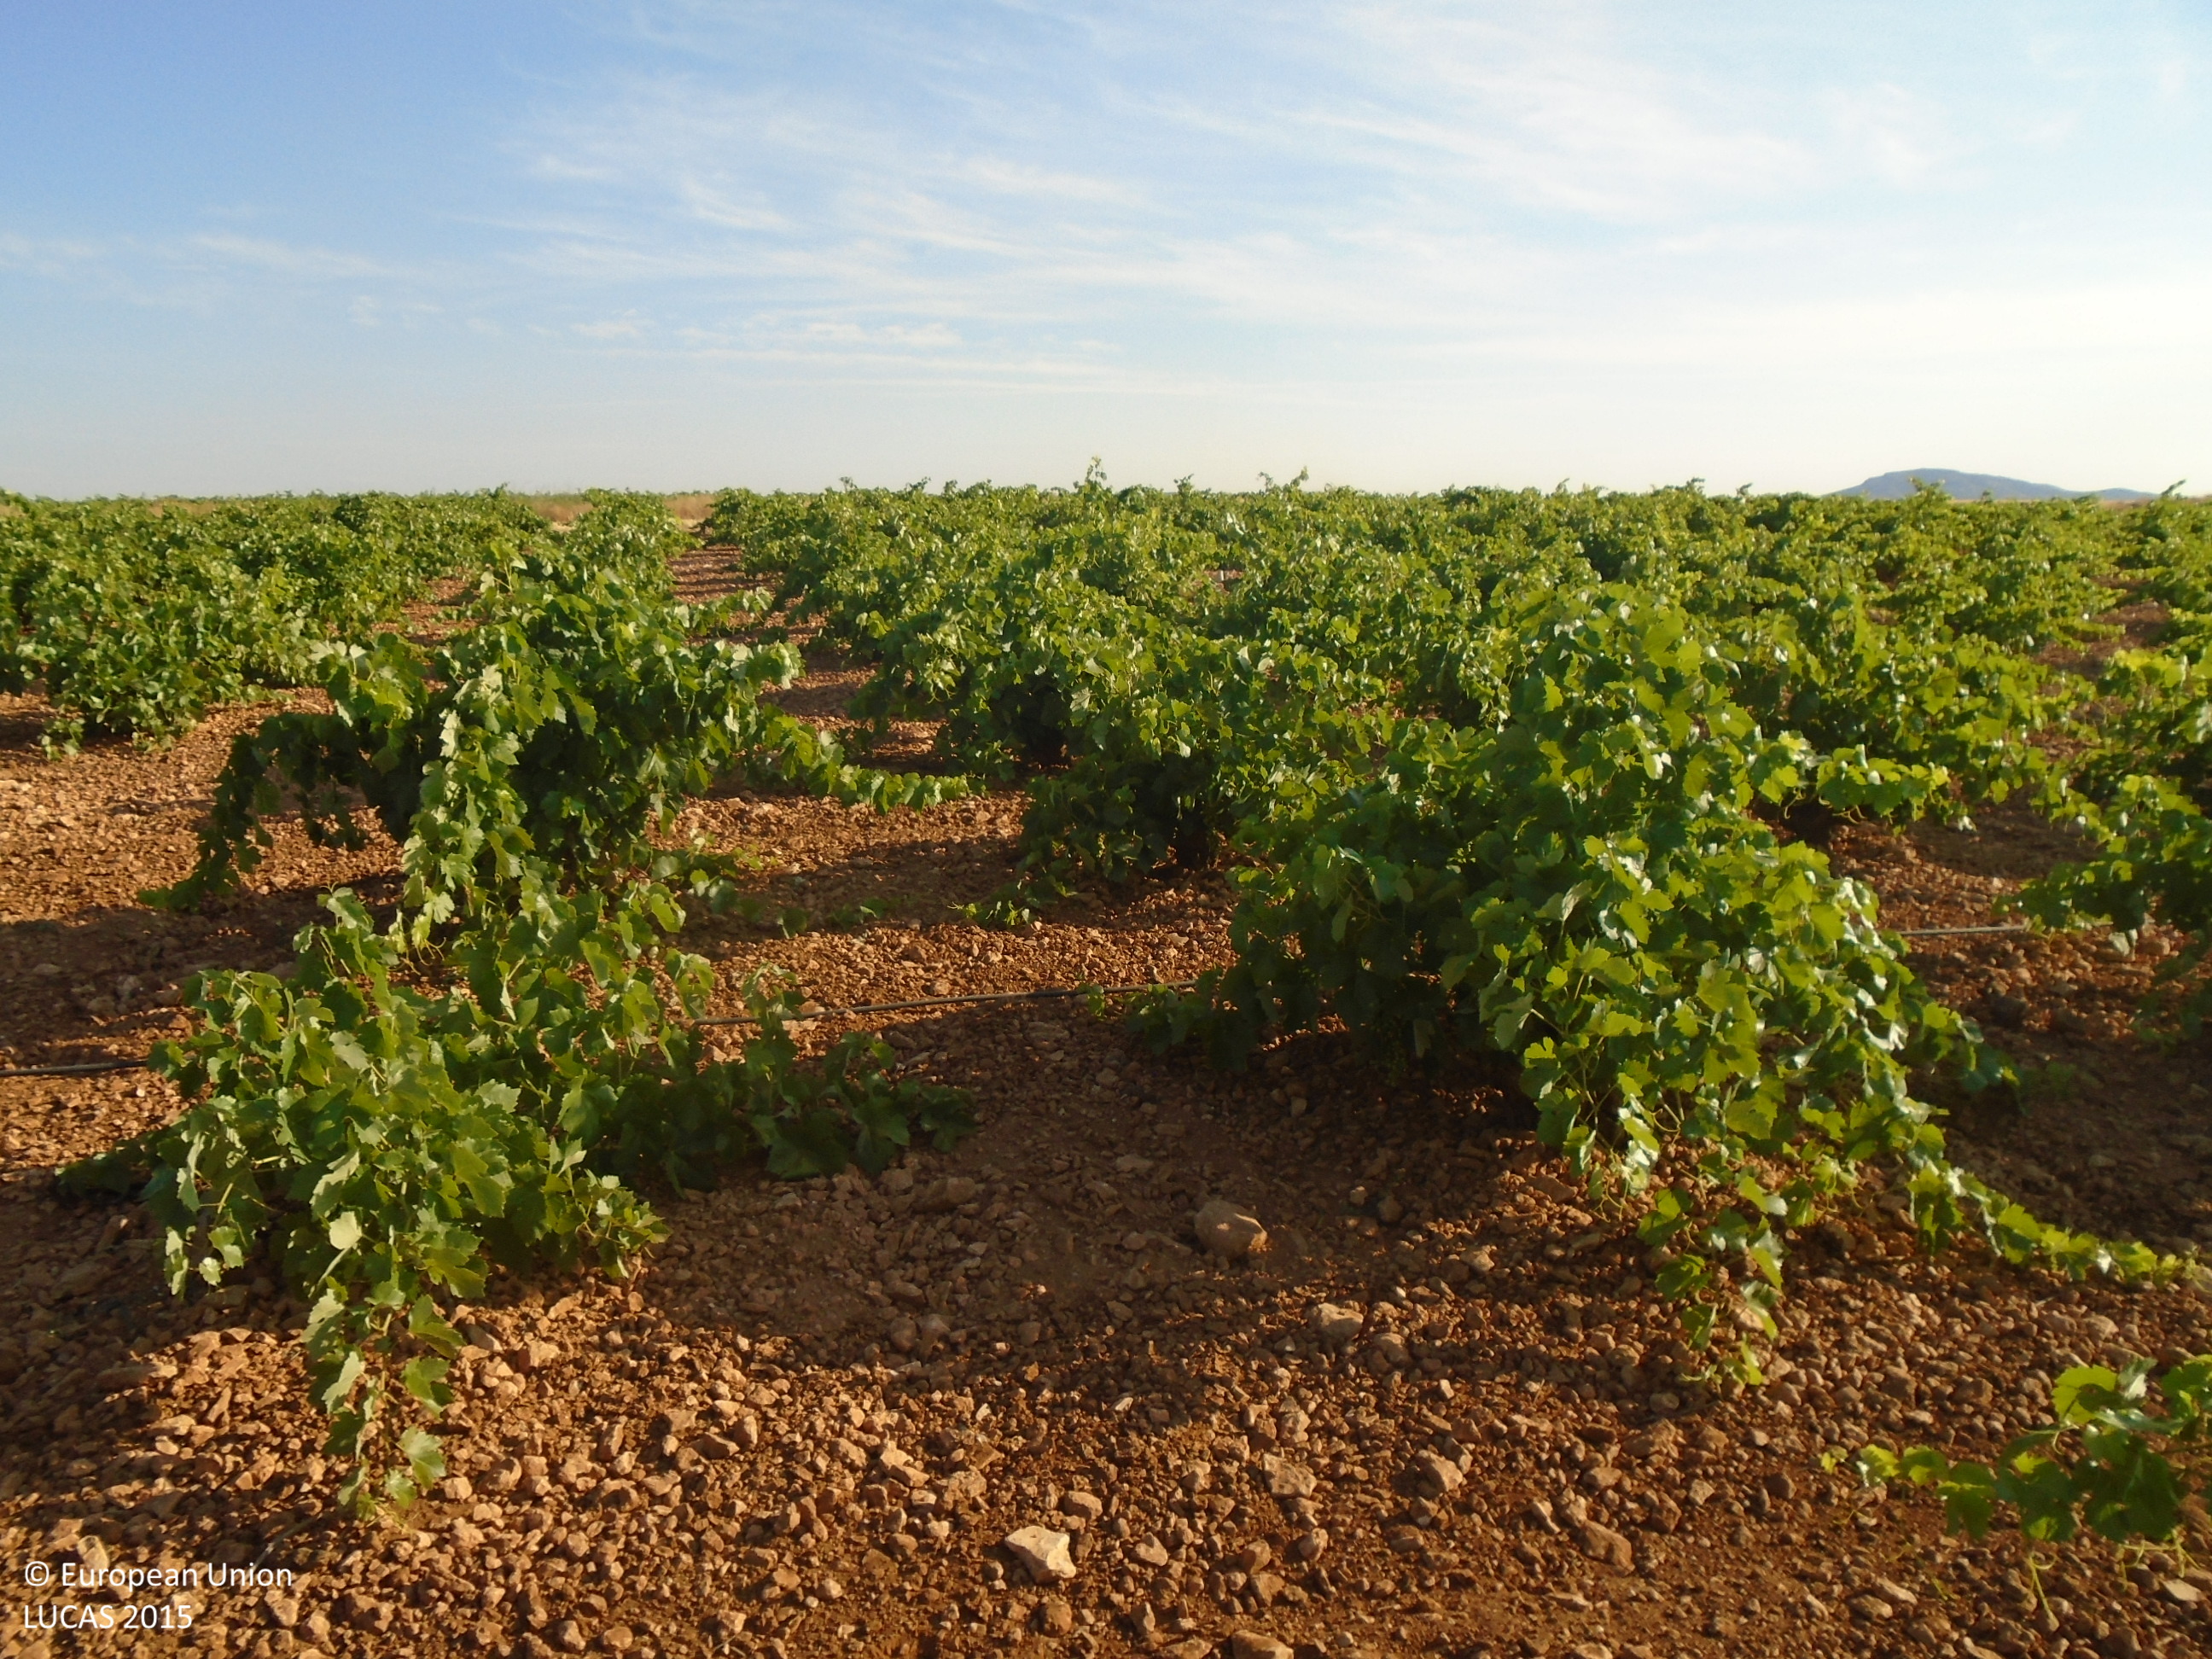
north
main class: Cropland
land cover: Vineyards
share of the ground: 25 - 50 %
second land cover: Other bare soil
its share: > 75 %
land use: Agriculture (excluding fallow land and kitchen gardens)
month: June
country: ES
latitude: 39.2599
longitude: -3.4741
